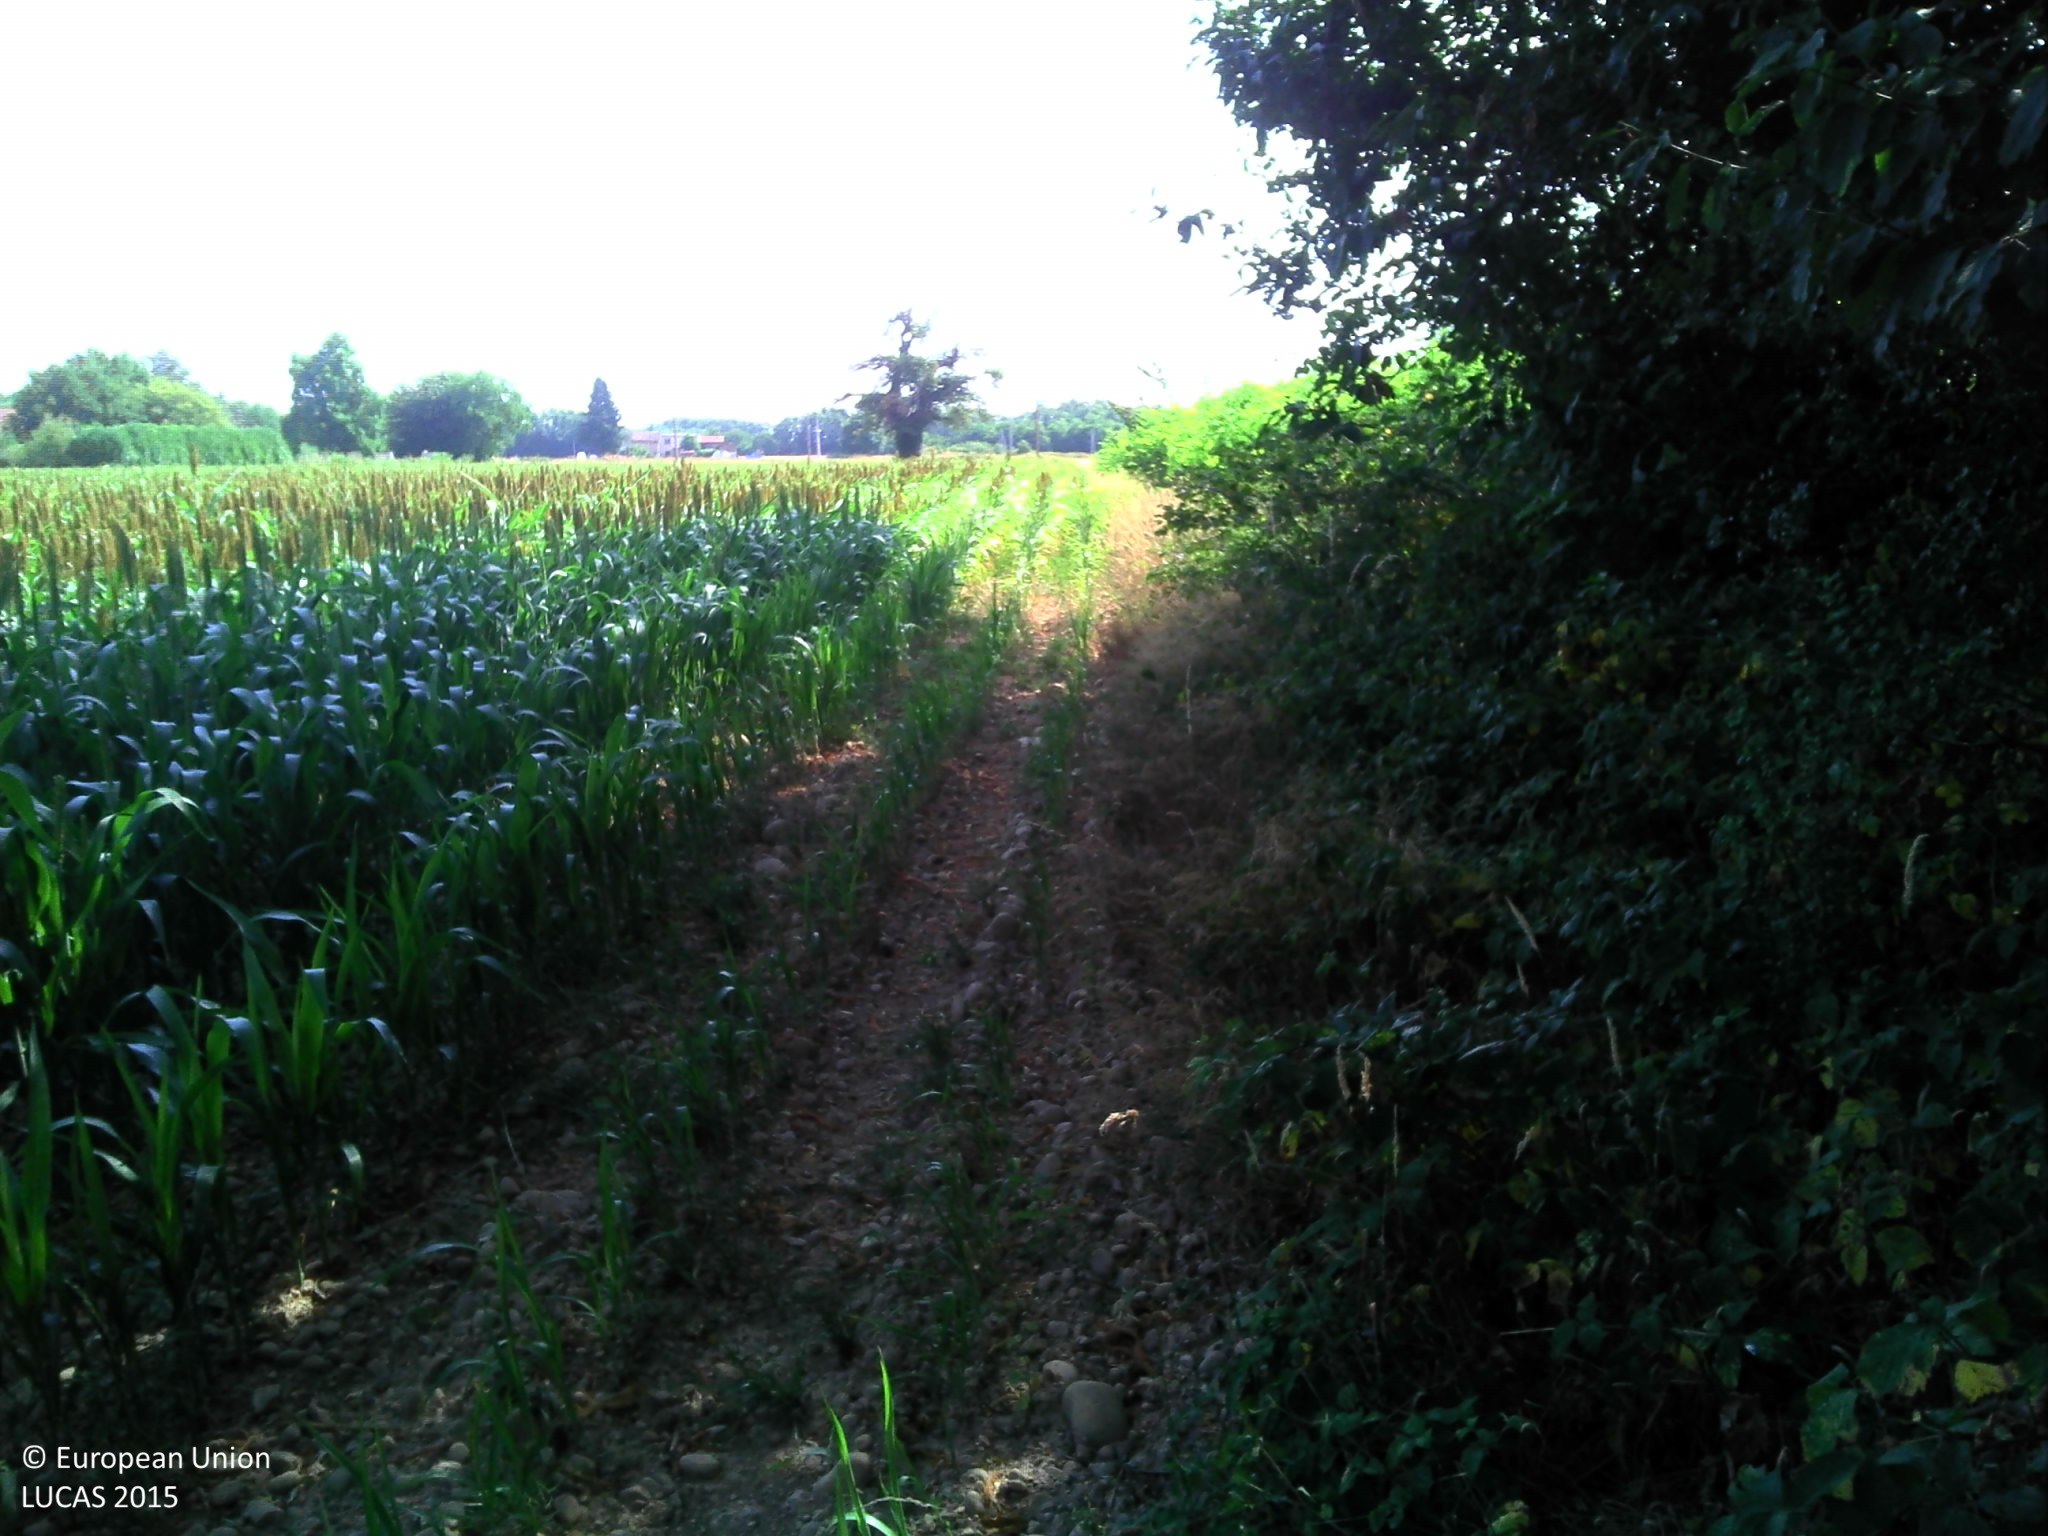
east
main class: Cropland
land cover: Other cereals
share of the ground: > 75 %
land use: Agriculture (excluding fallow land and kitchen gardens)
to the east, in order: Other cereals; Broadleaved woodland; Rye; Grass margins; Paved roads, cycling and walking lanes; Electric lines; Grass margins; Common wheat
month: July
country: FR
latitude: 45.3325
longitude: 5.0157
